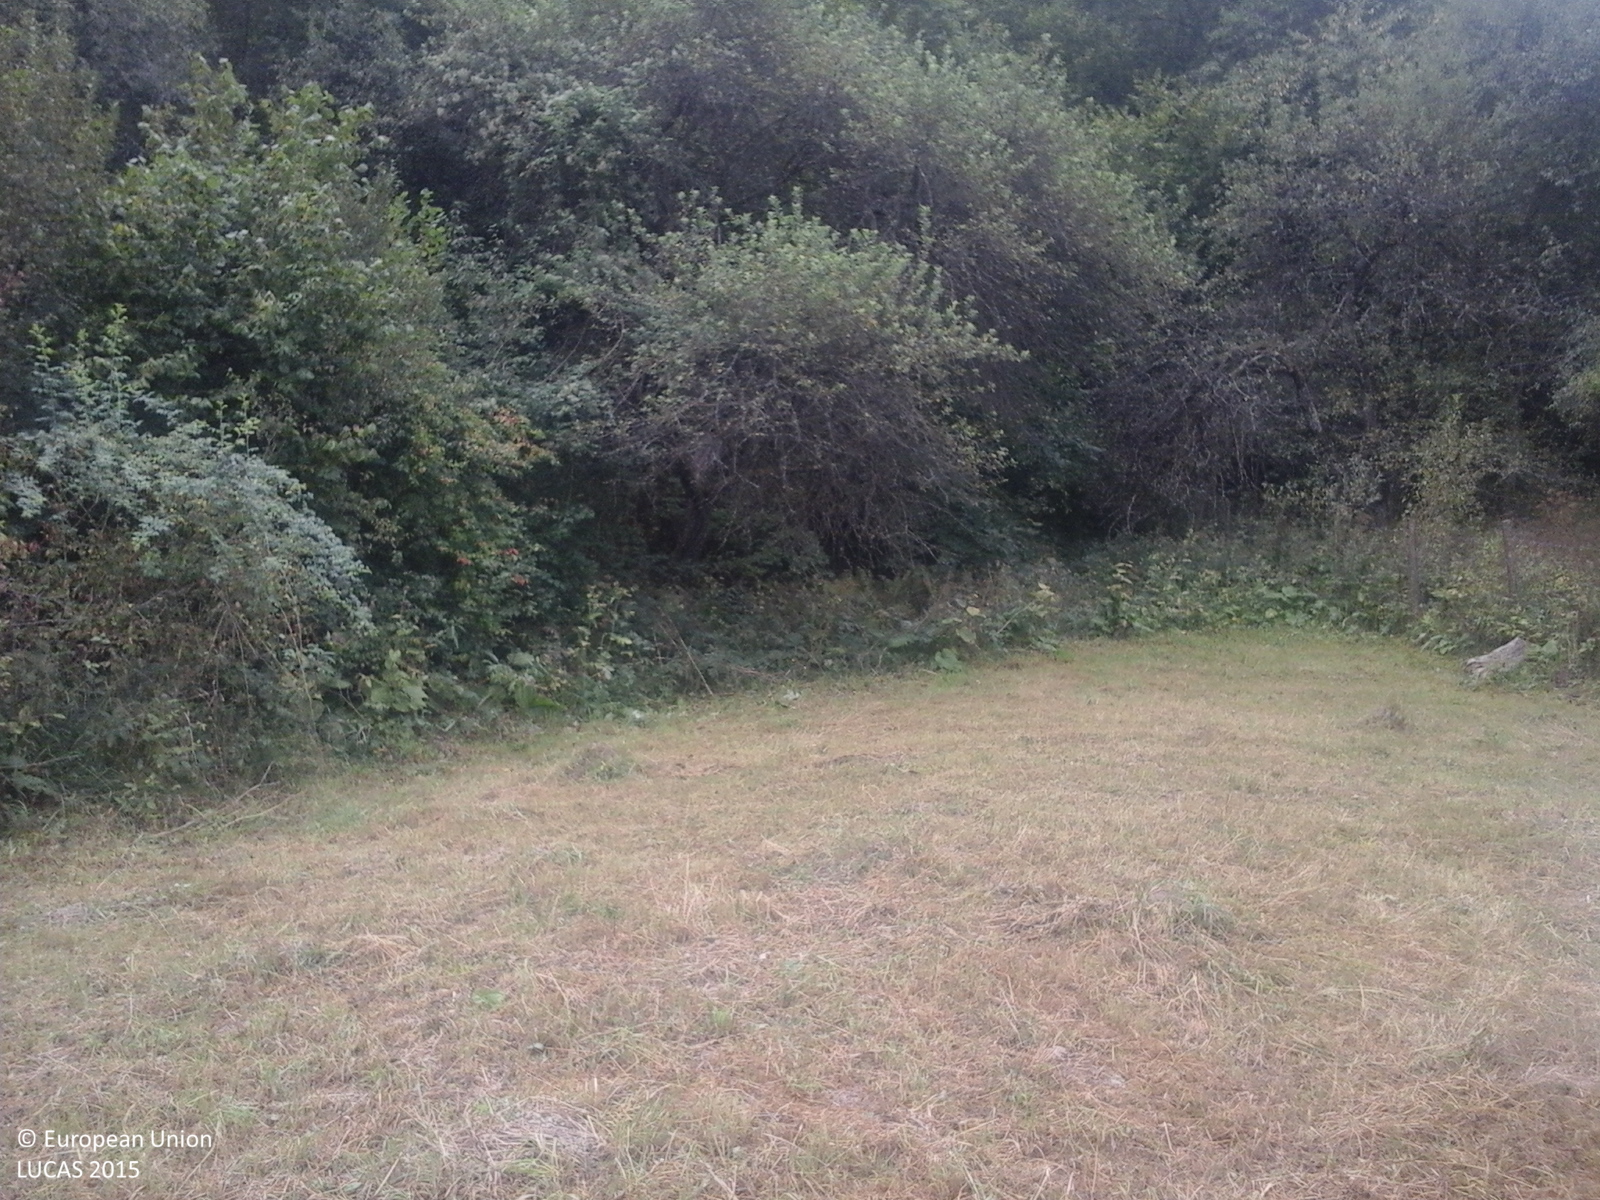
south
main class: Grassland
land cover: Grassland without tree/shrub cover
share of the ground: > 75 %
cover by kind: herbaceous plants 100 %
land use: Agriculture (excluding fallow land and kitchen gardens)
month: September
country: RO
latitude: 47.9994
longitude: 23.5742
